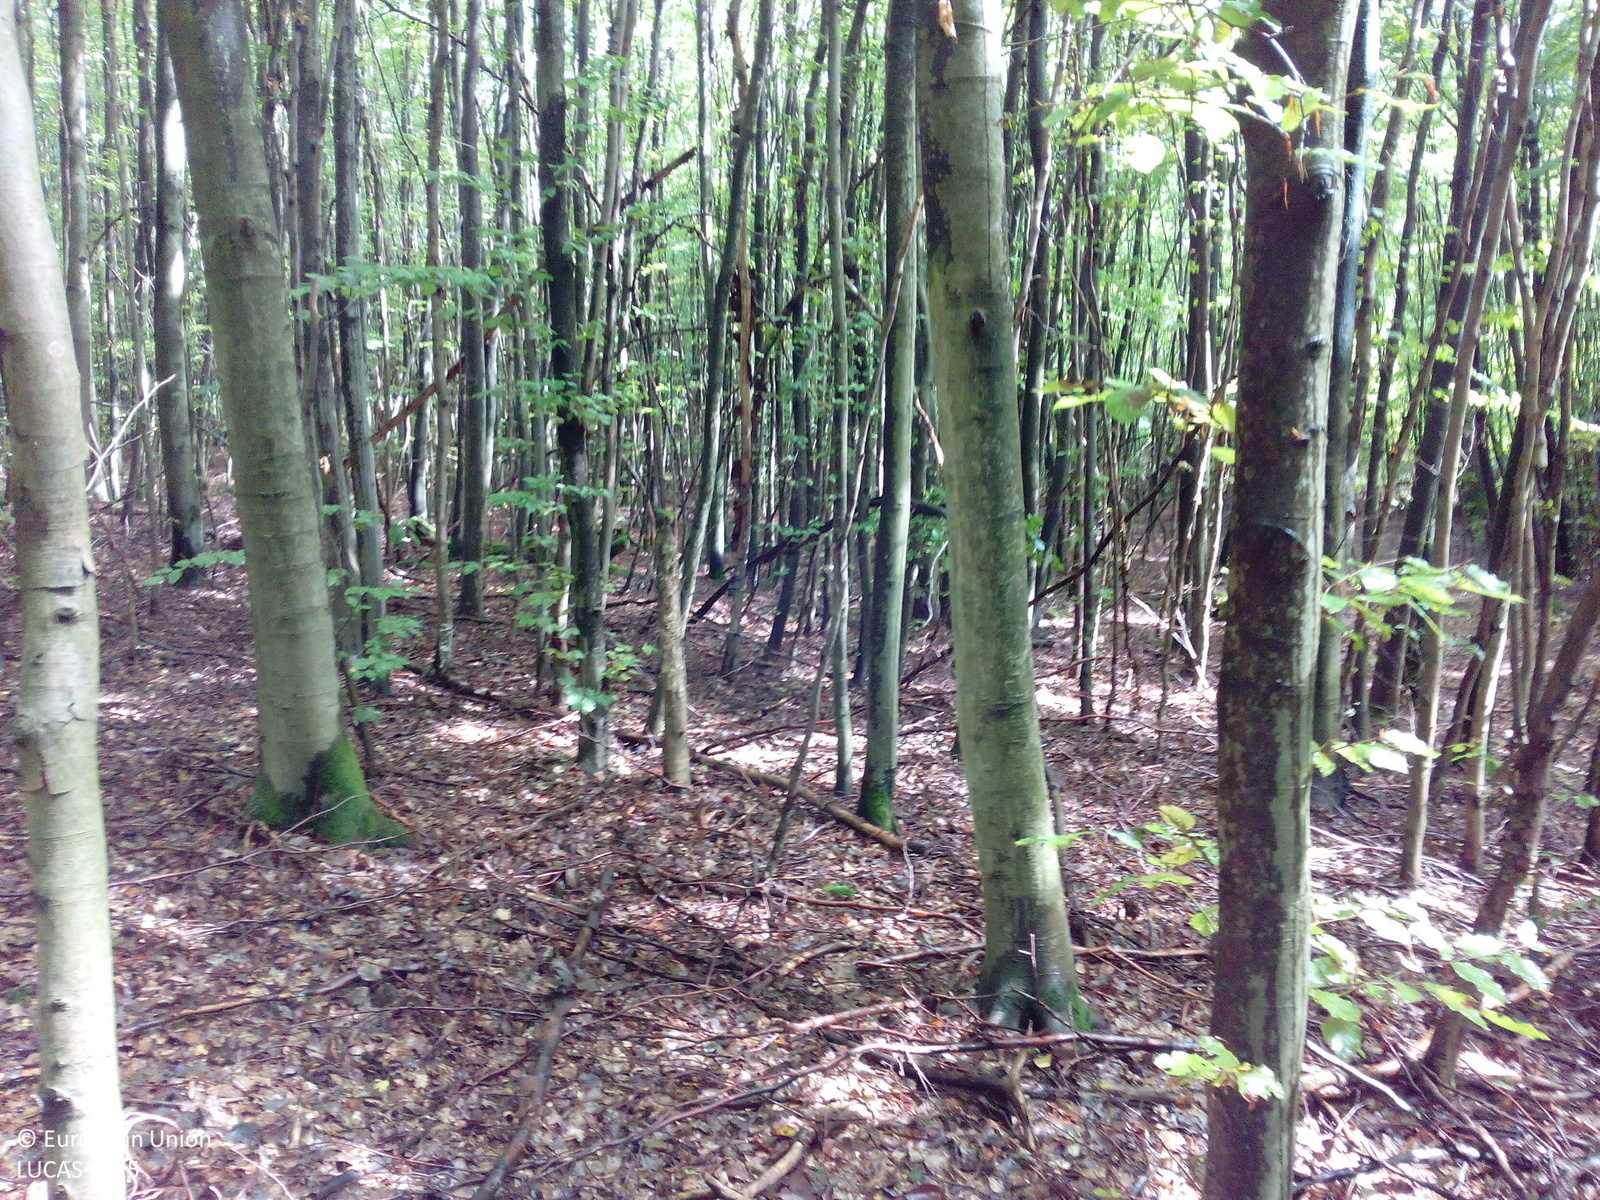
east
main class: Woodland
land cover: Broadleaved woodland
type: beech forest
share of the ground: > 75 %
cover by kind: broadleaved forest trees 100 %
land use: Forestry
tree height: > 5 m
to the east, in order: Broadleaved woodland; Tracks; Broadleaved woodland; Grass margins; Tracks; Grass margins; Broadleaved woodland
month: September
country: DE
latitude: 50.0755
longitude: 9.5670
